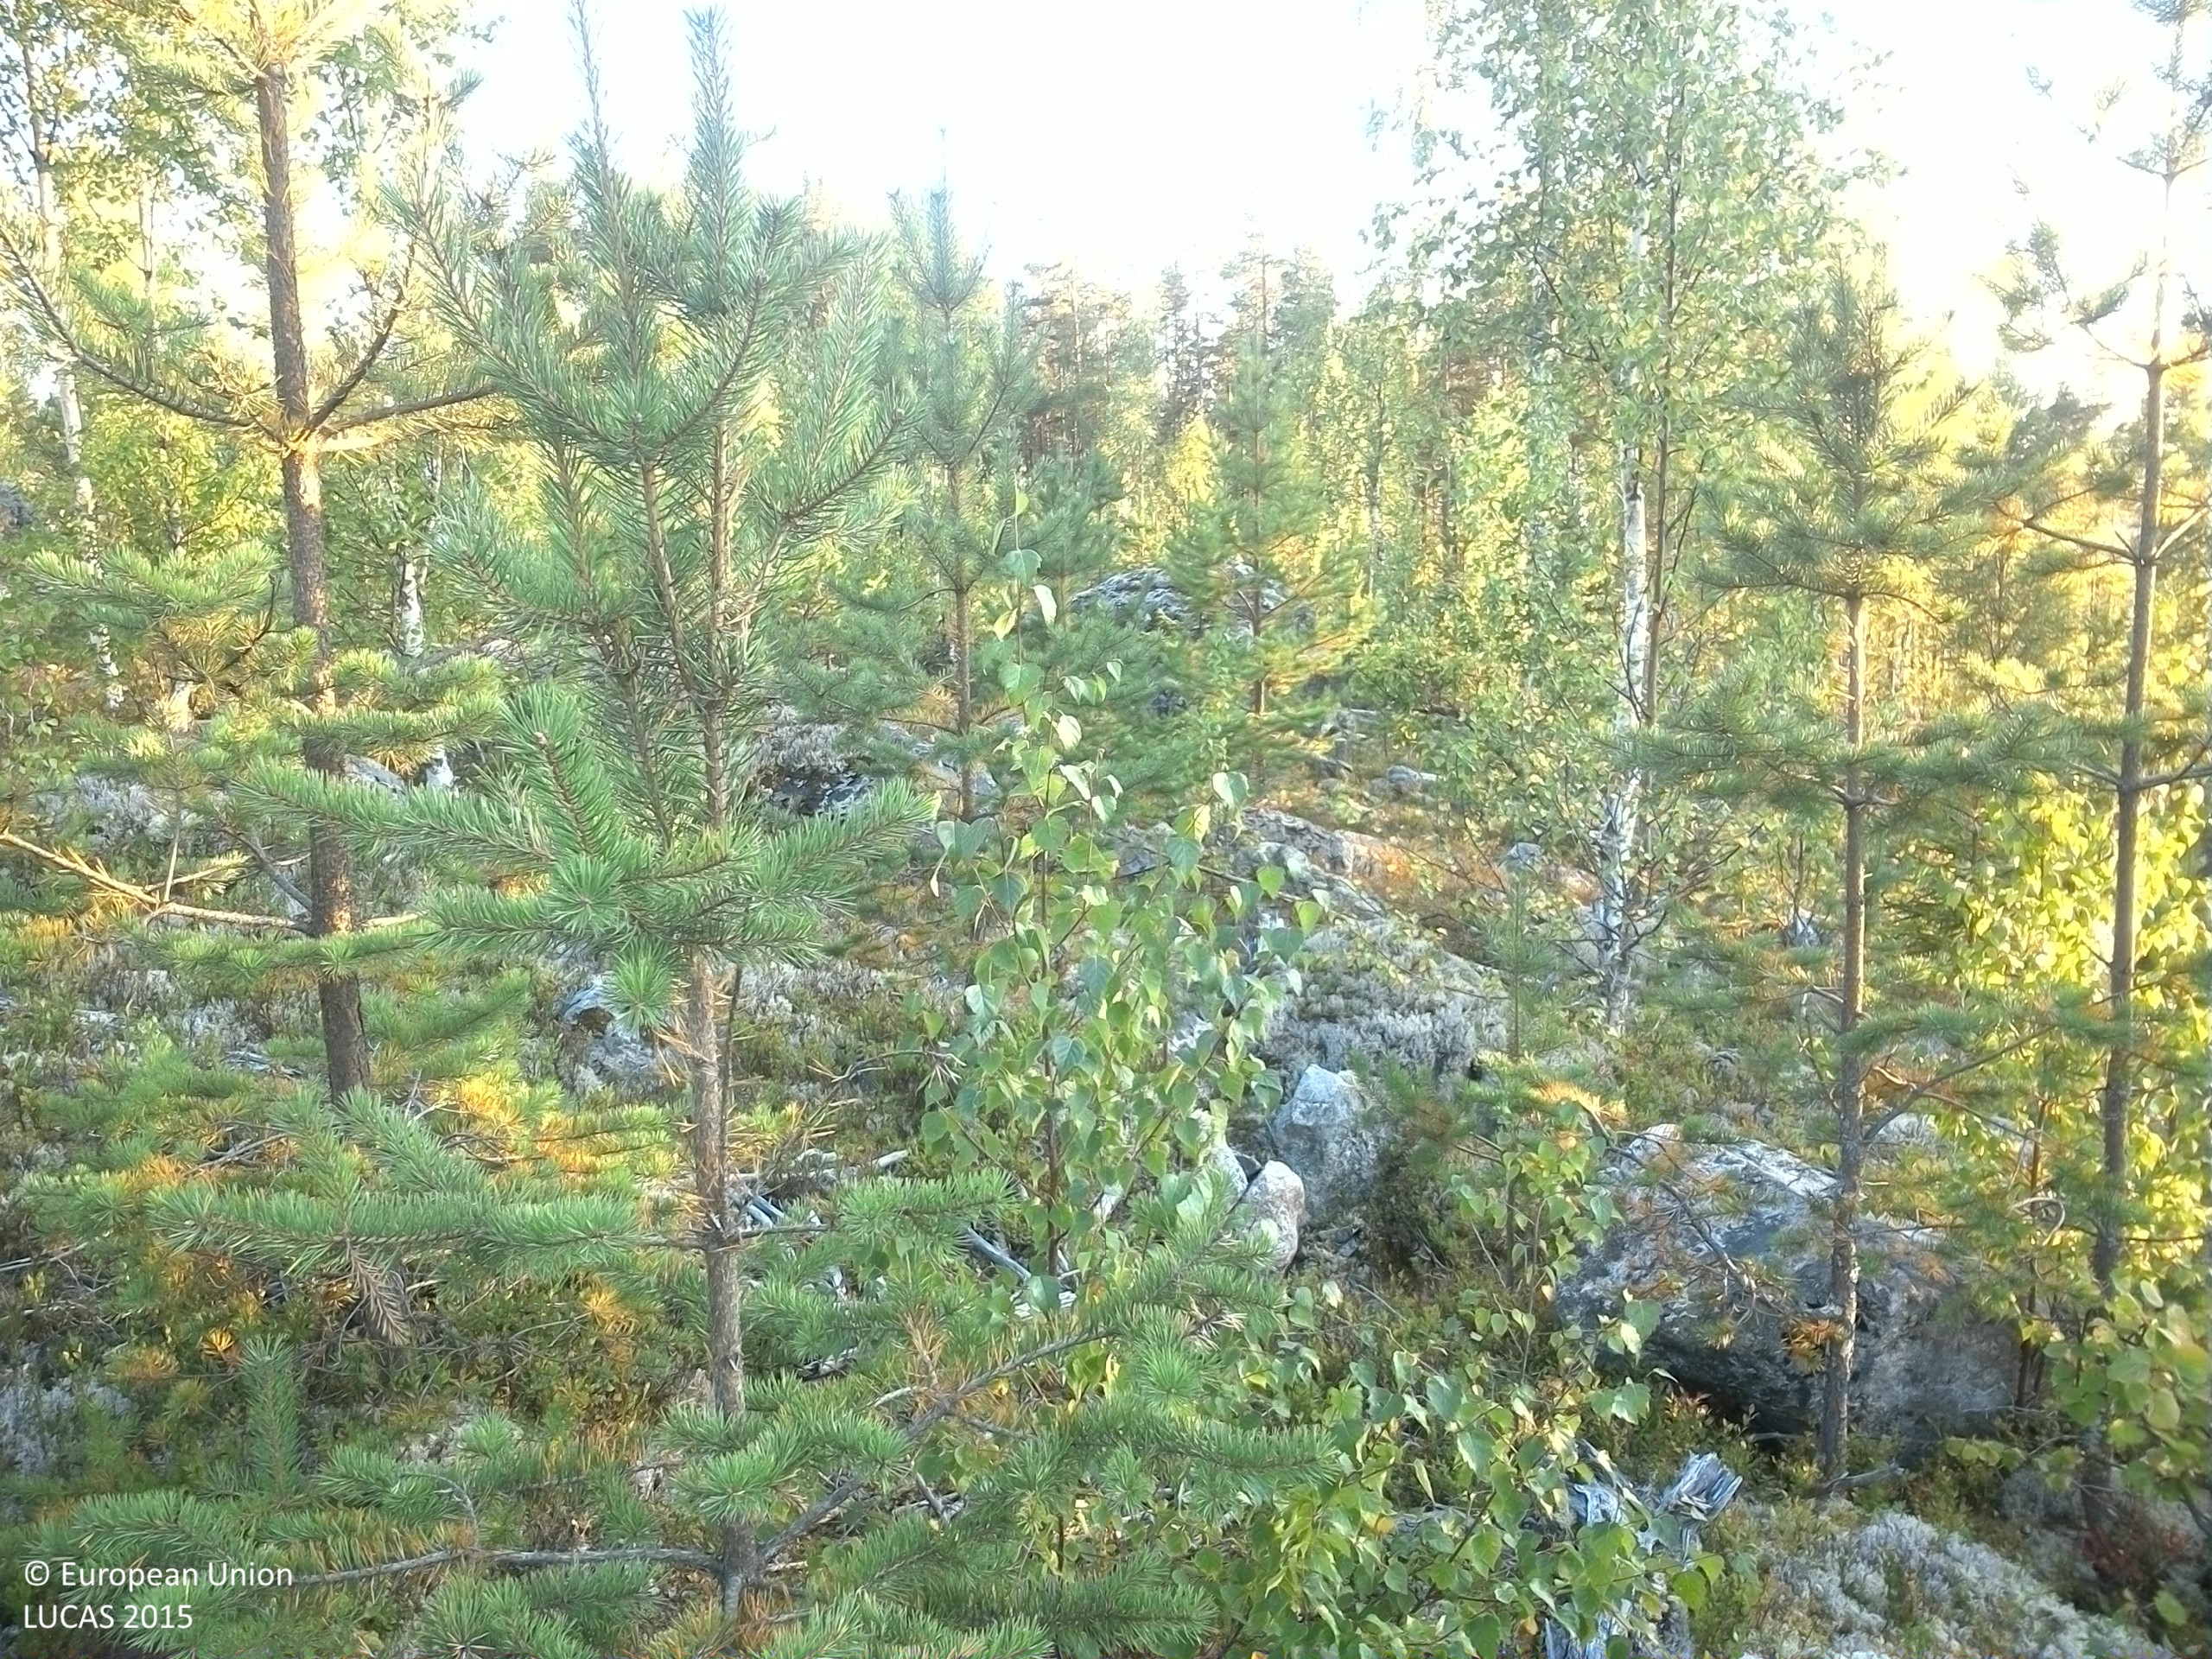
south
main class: Woodland
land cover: Pine dominated mixed woodland
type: boreal forest
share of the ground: 25 - 50 %
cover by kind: coniferous forest trees 30 %, shrubs 30 %, broadleaved forest trees 15 %, consolidated bare surface 15 %, lichens and mosses 10 %
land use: Forestry
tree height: < 5 m
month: September
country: SE
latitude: 61.6481
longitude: 15.4010
